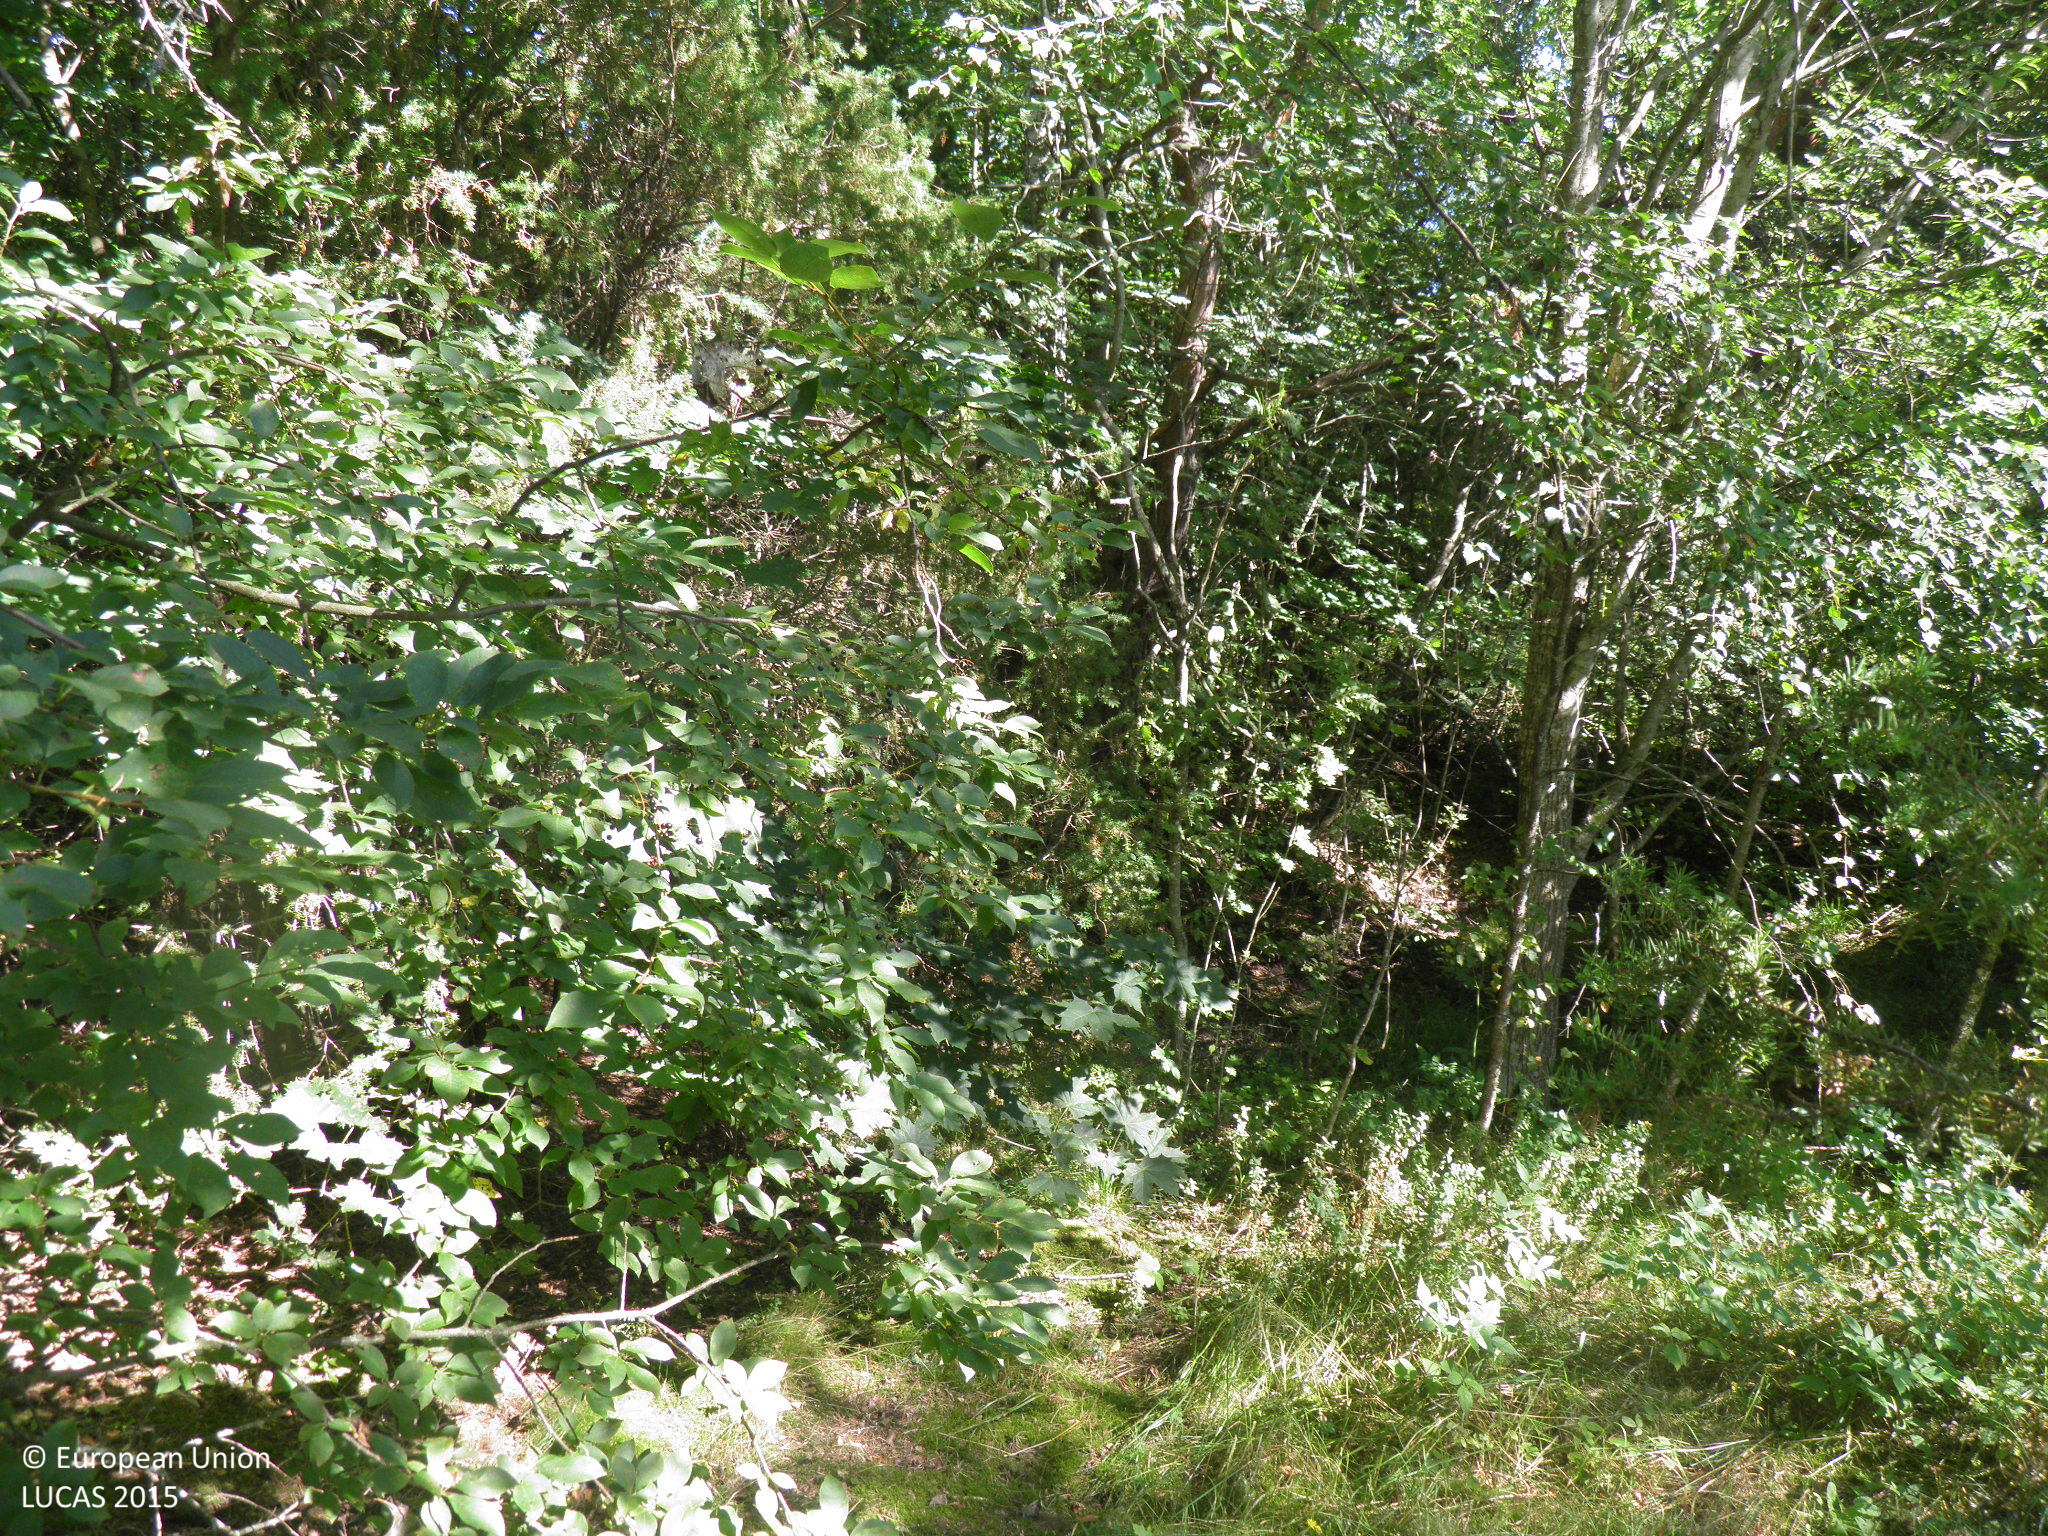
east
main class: Woodland
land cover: Pine dominated mixed woodland
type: hemiboreal forest and nemoral coniferous forest and mixed broadleaved-coniferous forest
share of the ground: > 75 %
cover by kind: coniferous forest trees 55 %, broadleaved forest trees 35 %, herbaceous plants 10 %
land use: Abandoned areas
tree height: > 5 m
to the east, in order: Pine dominated mixed woodland; Conifer hedges; Electric lines; Ditches and canals; Grass margins; Paved roads, cycling and walking lanes; Grass margins; Ditches and canals; Other mixed woodland; Artificial constructions in urban areas; Shrubland without tree cover; Grassland with sparse tree/shrub cover; Broadleaved woodland; Inland fresh running water; Broadleaved woodland; Artificial constructions in urban areas; Grassland without tree/shrub cover; Other bare soil
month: August
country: FI
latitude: 60.8166
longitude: 21.5460
